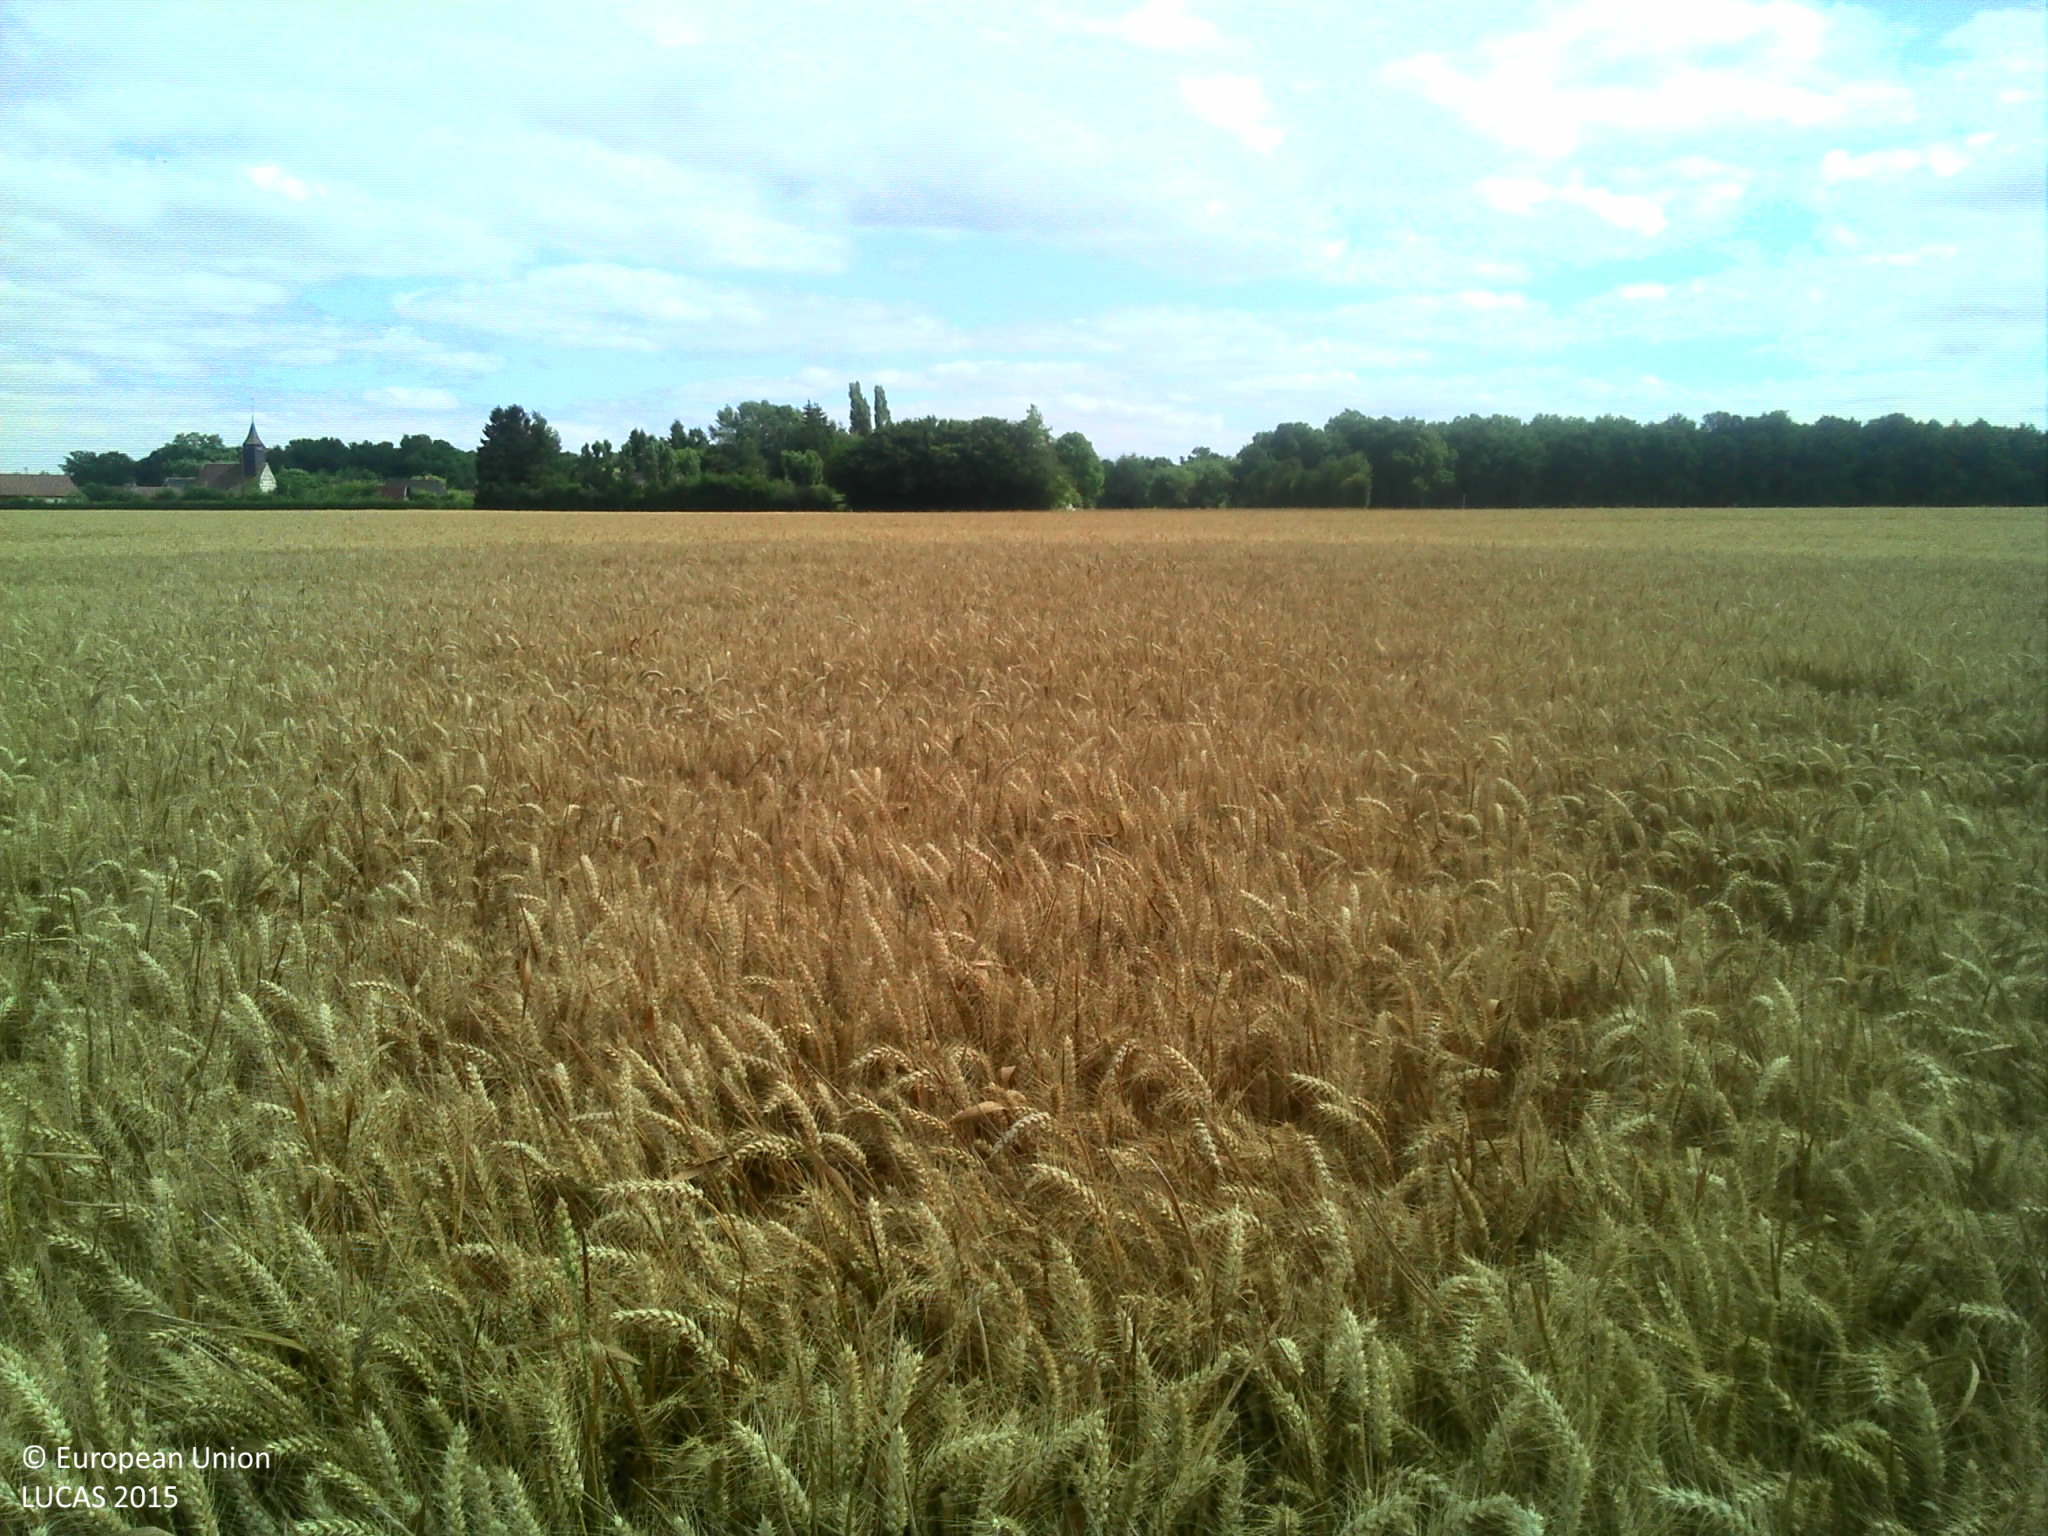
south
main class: Cropland
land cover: Common wheat
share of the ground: > 75 %
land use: Agriculture (excluding fallow land and kitchen gardens)
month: July
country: FR
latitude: 48.9528
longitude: 0.7036
